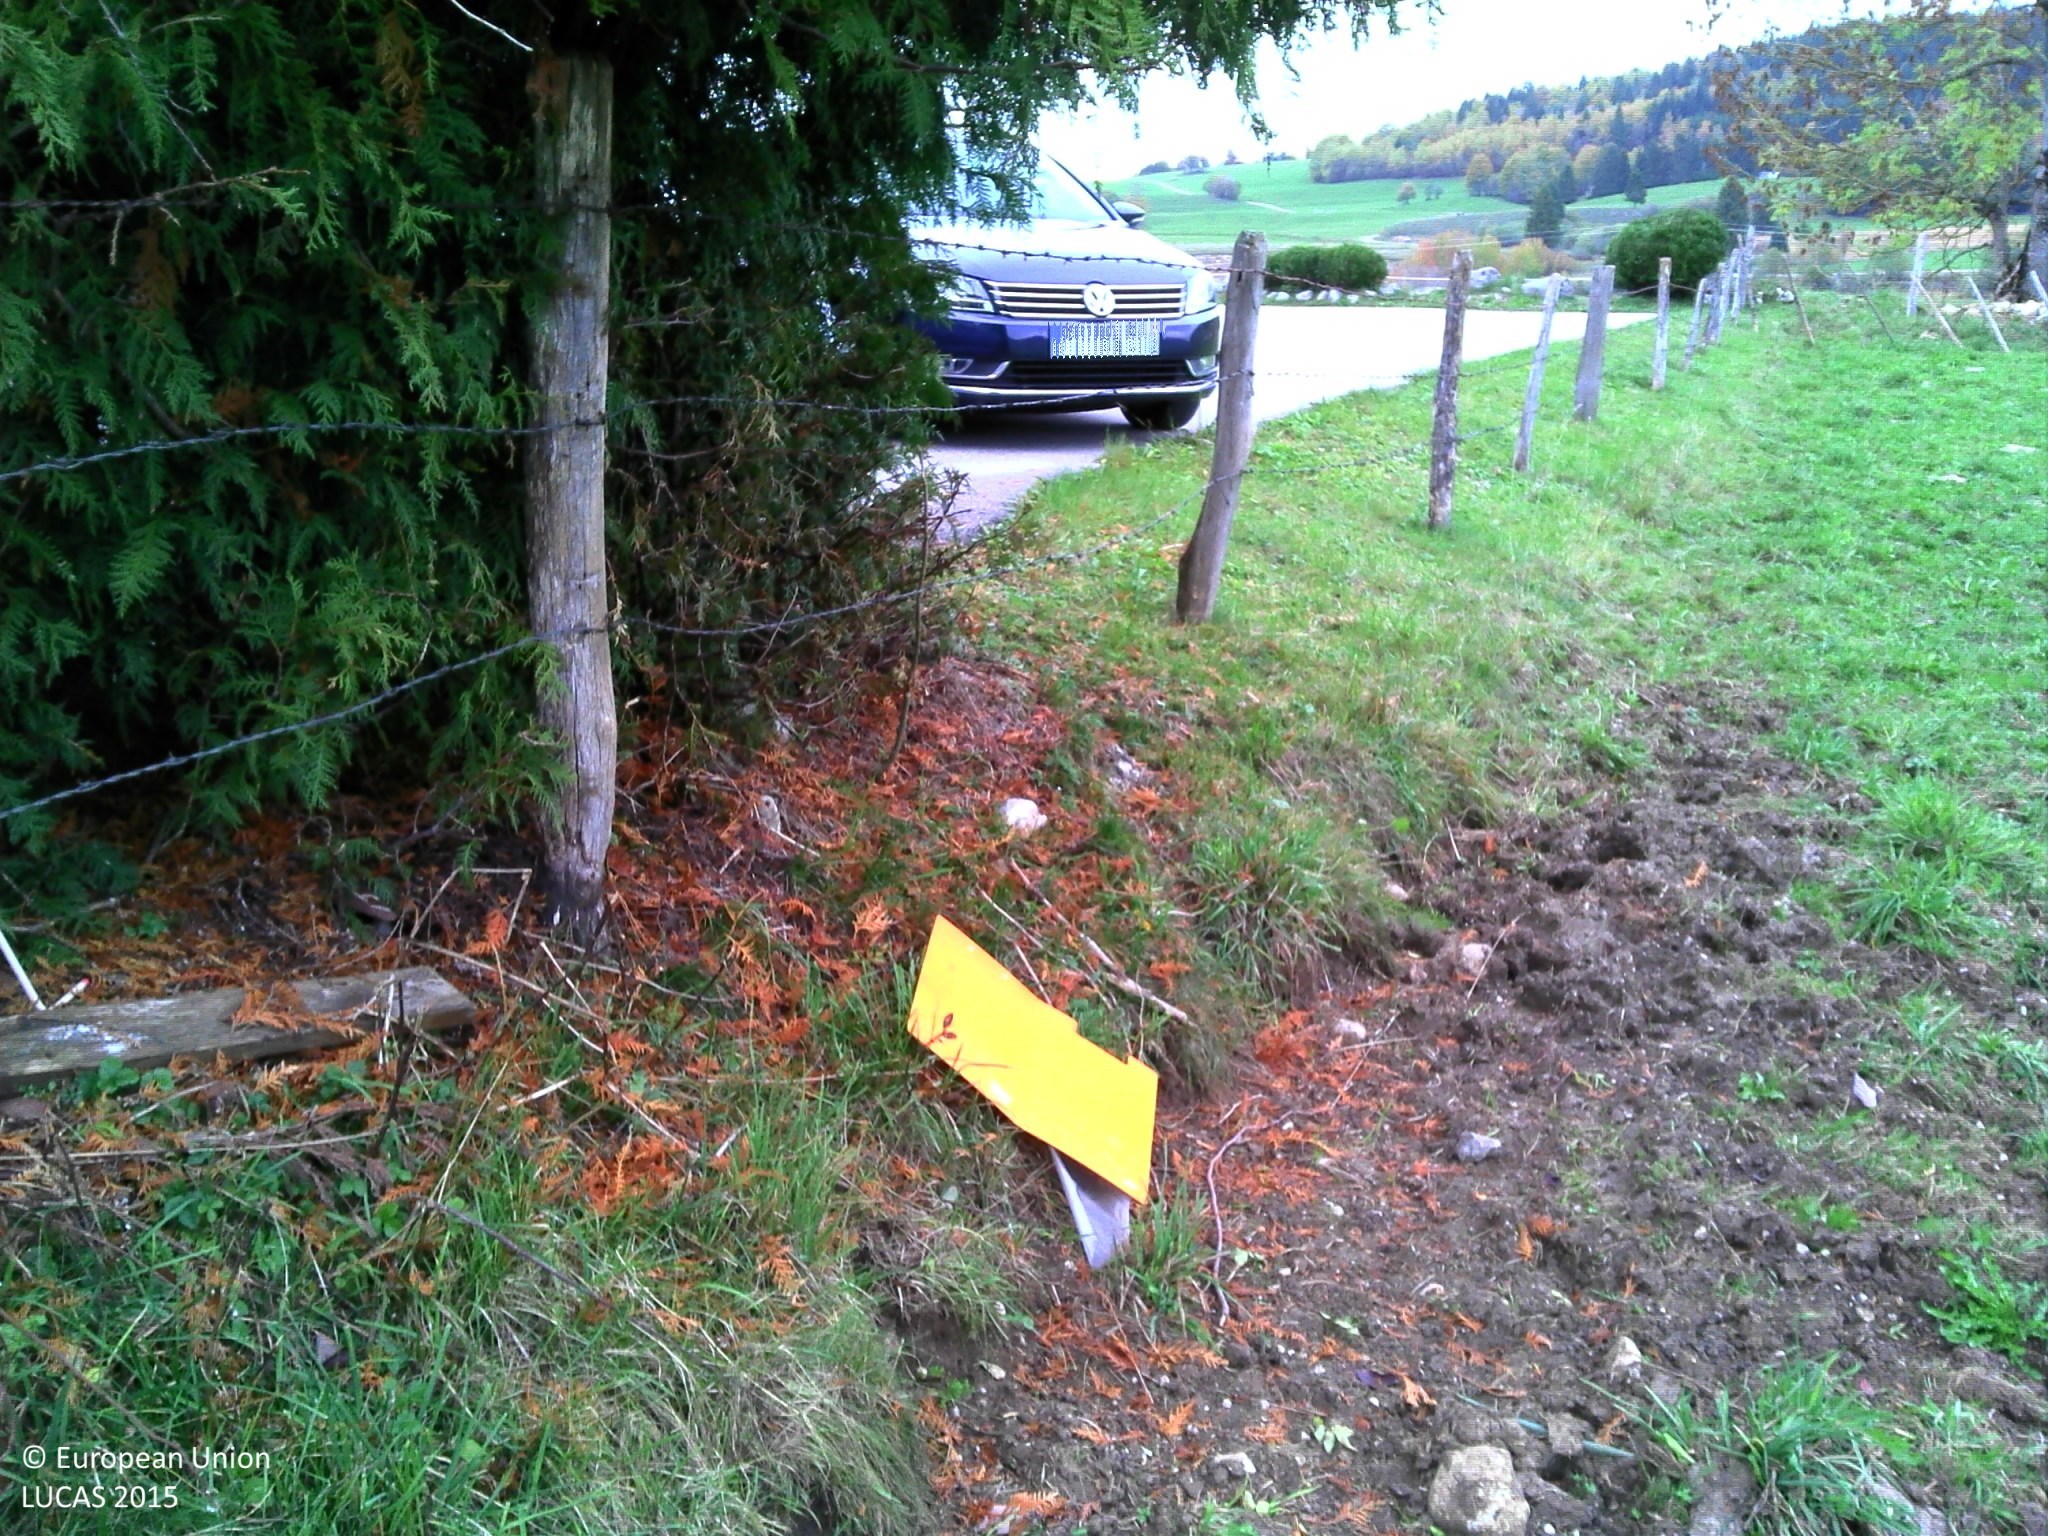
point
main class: Grassland
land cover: Grassland without tree/shrub cover
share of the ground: > 75 %
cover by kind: herbaceous plants 100 %
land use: Agriculture (excluding fallow land and kitchen gardens)
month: October
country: FR
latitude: 46.7370
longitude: 6.2728
